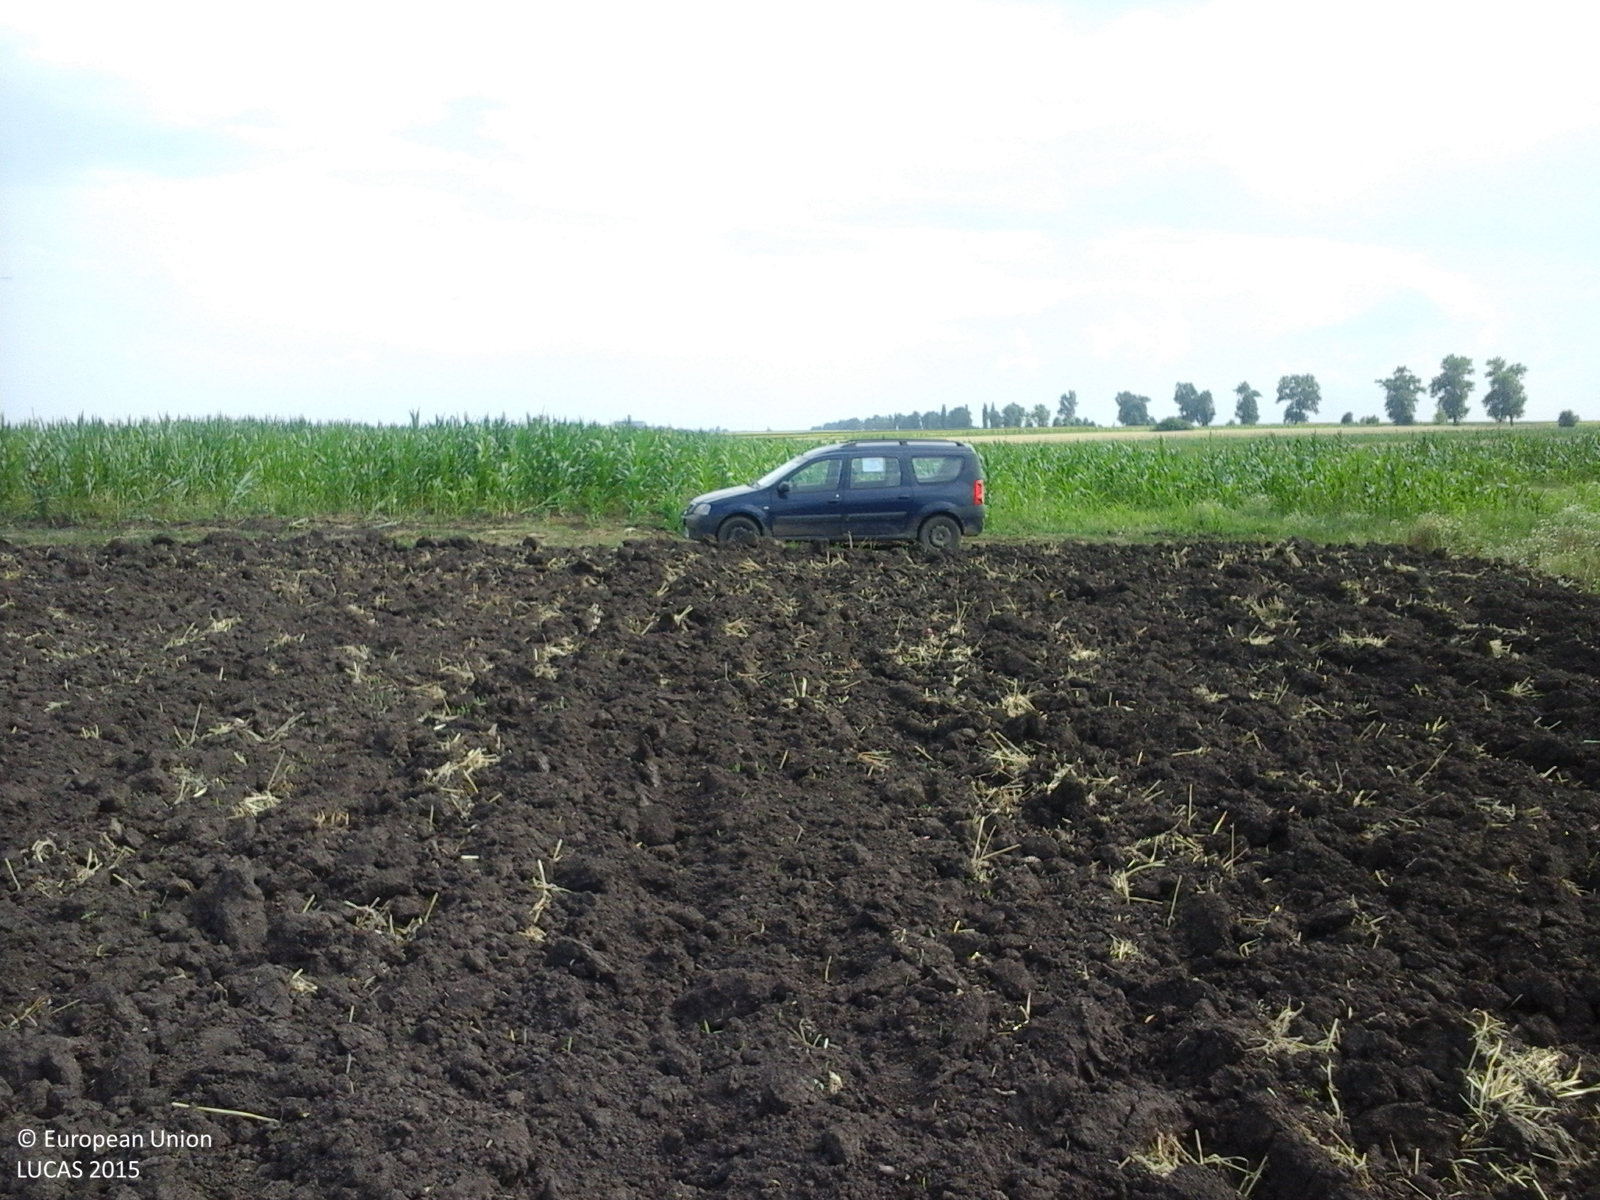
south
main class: Cropland
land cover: Common wheat
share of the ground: < 10 %
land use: Agriculture (excluding fallow land and kitchen gardens)
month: July
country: RO
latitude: 44.0159
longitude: 25.7732
